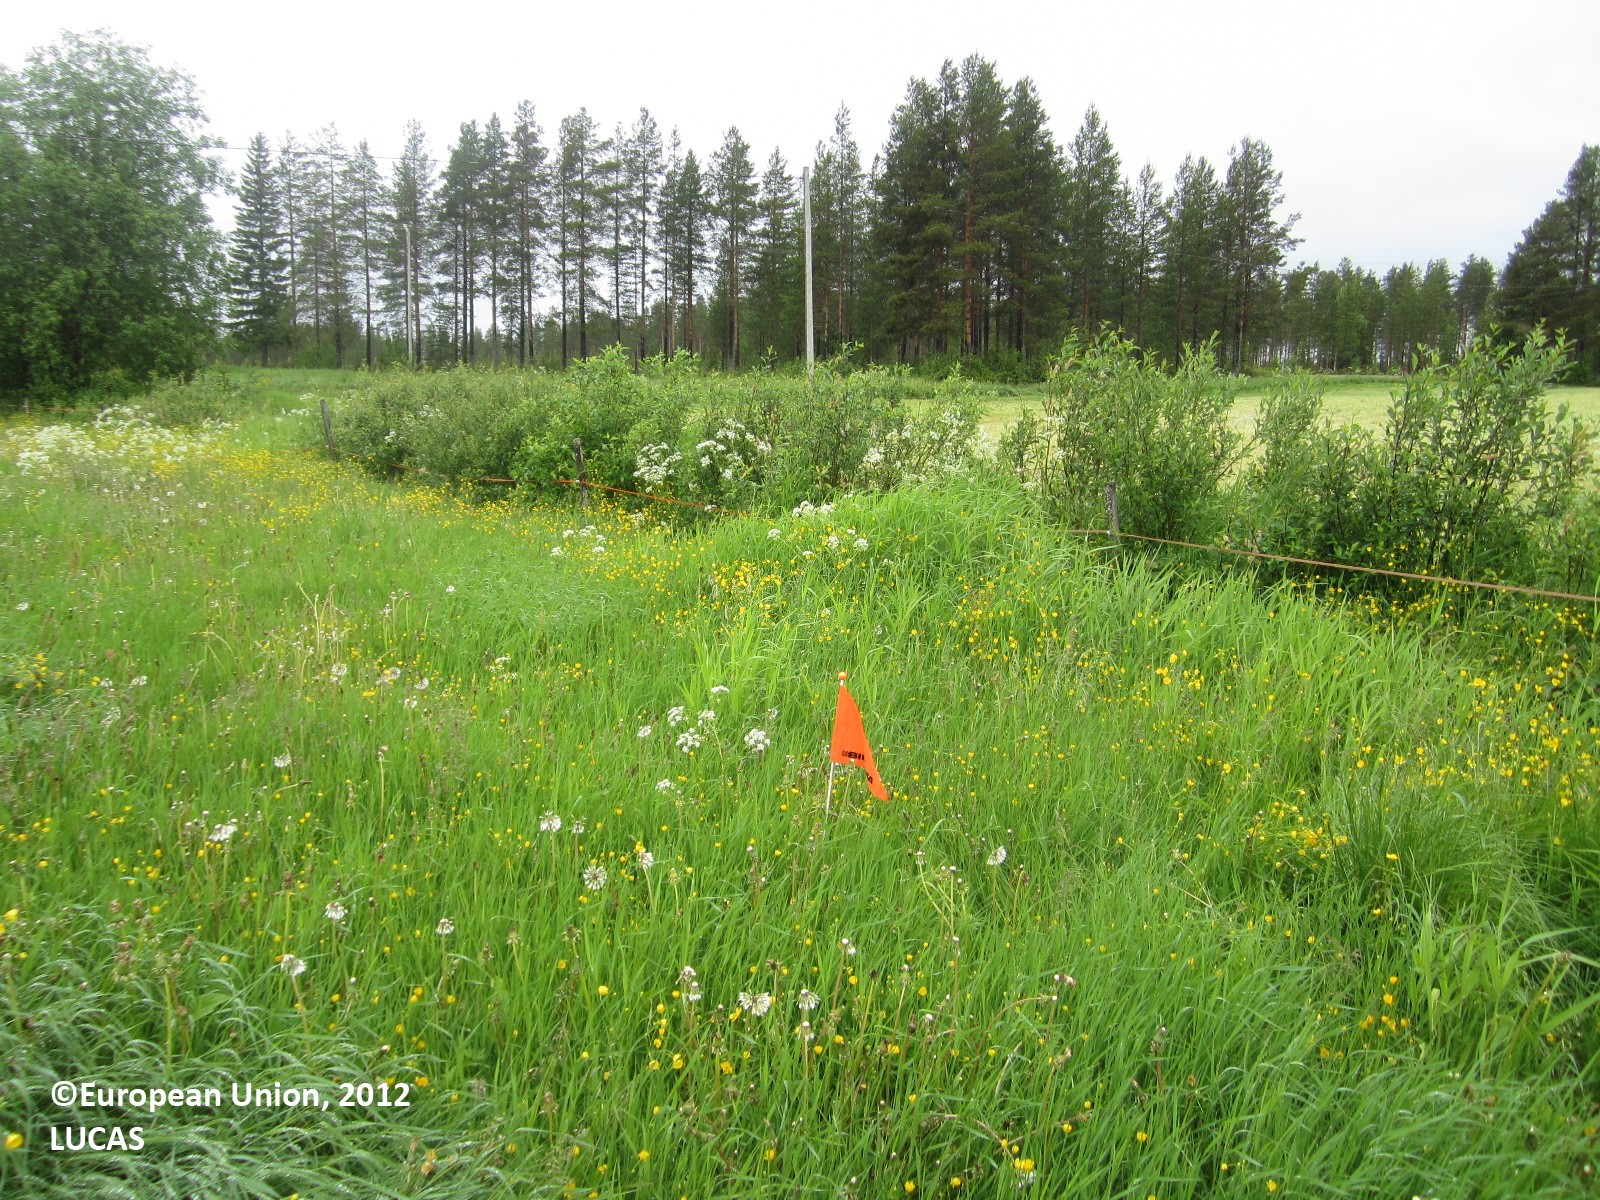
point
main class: Grassland
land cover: Grassland without tree/shrub cover
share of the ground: > 75 %
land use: Agriculture (excluding fallow land and kitchen gardens)
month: June
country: FI
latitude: 64.3054
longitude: 29.5460
